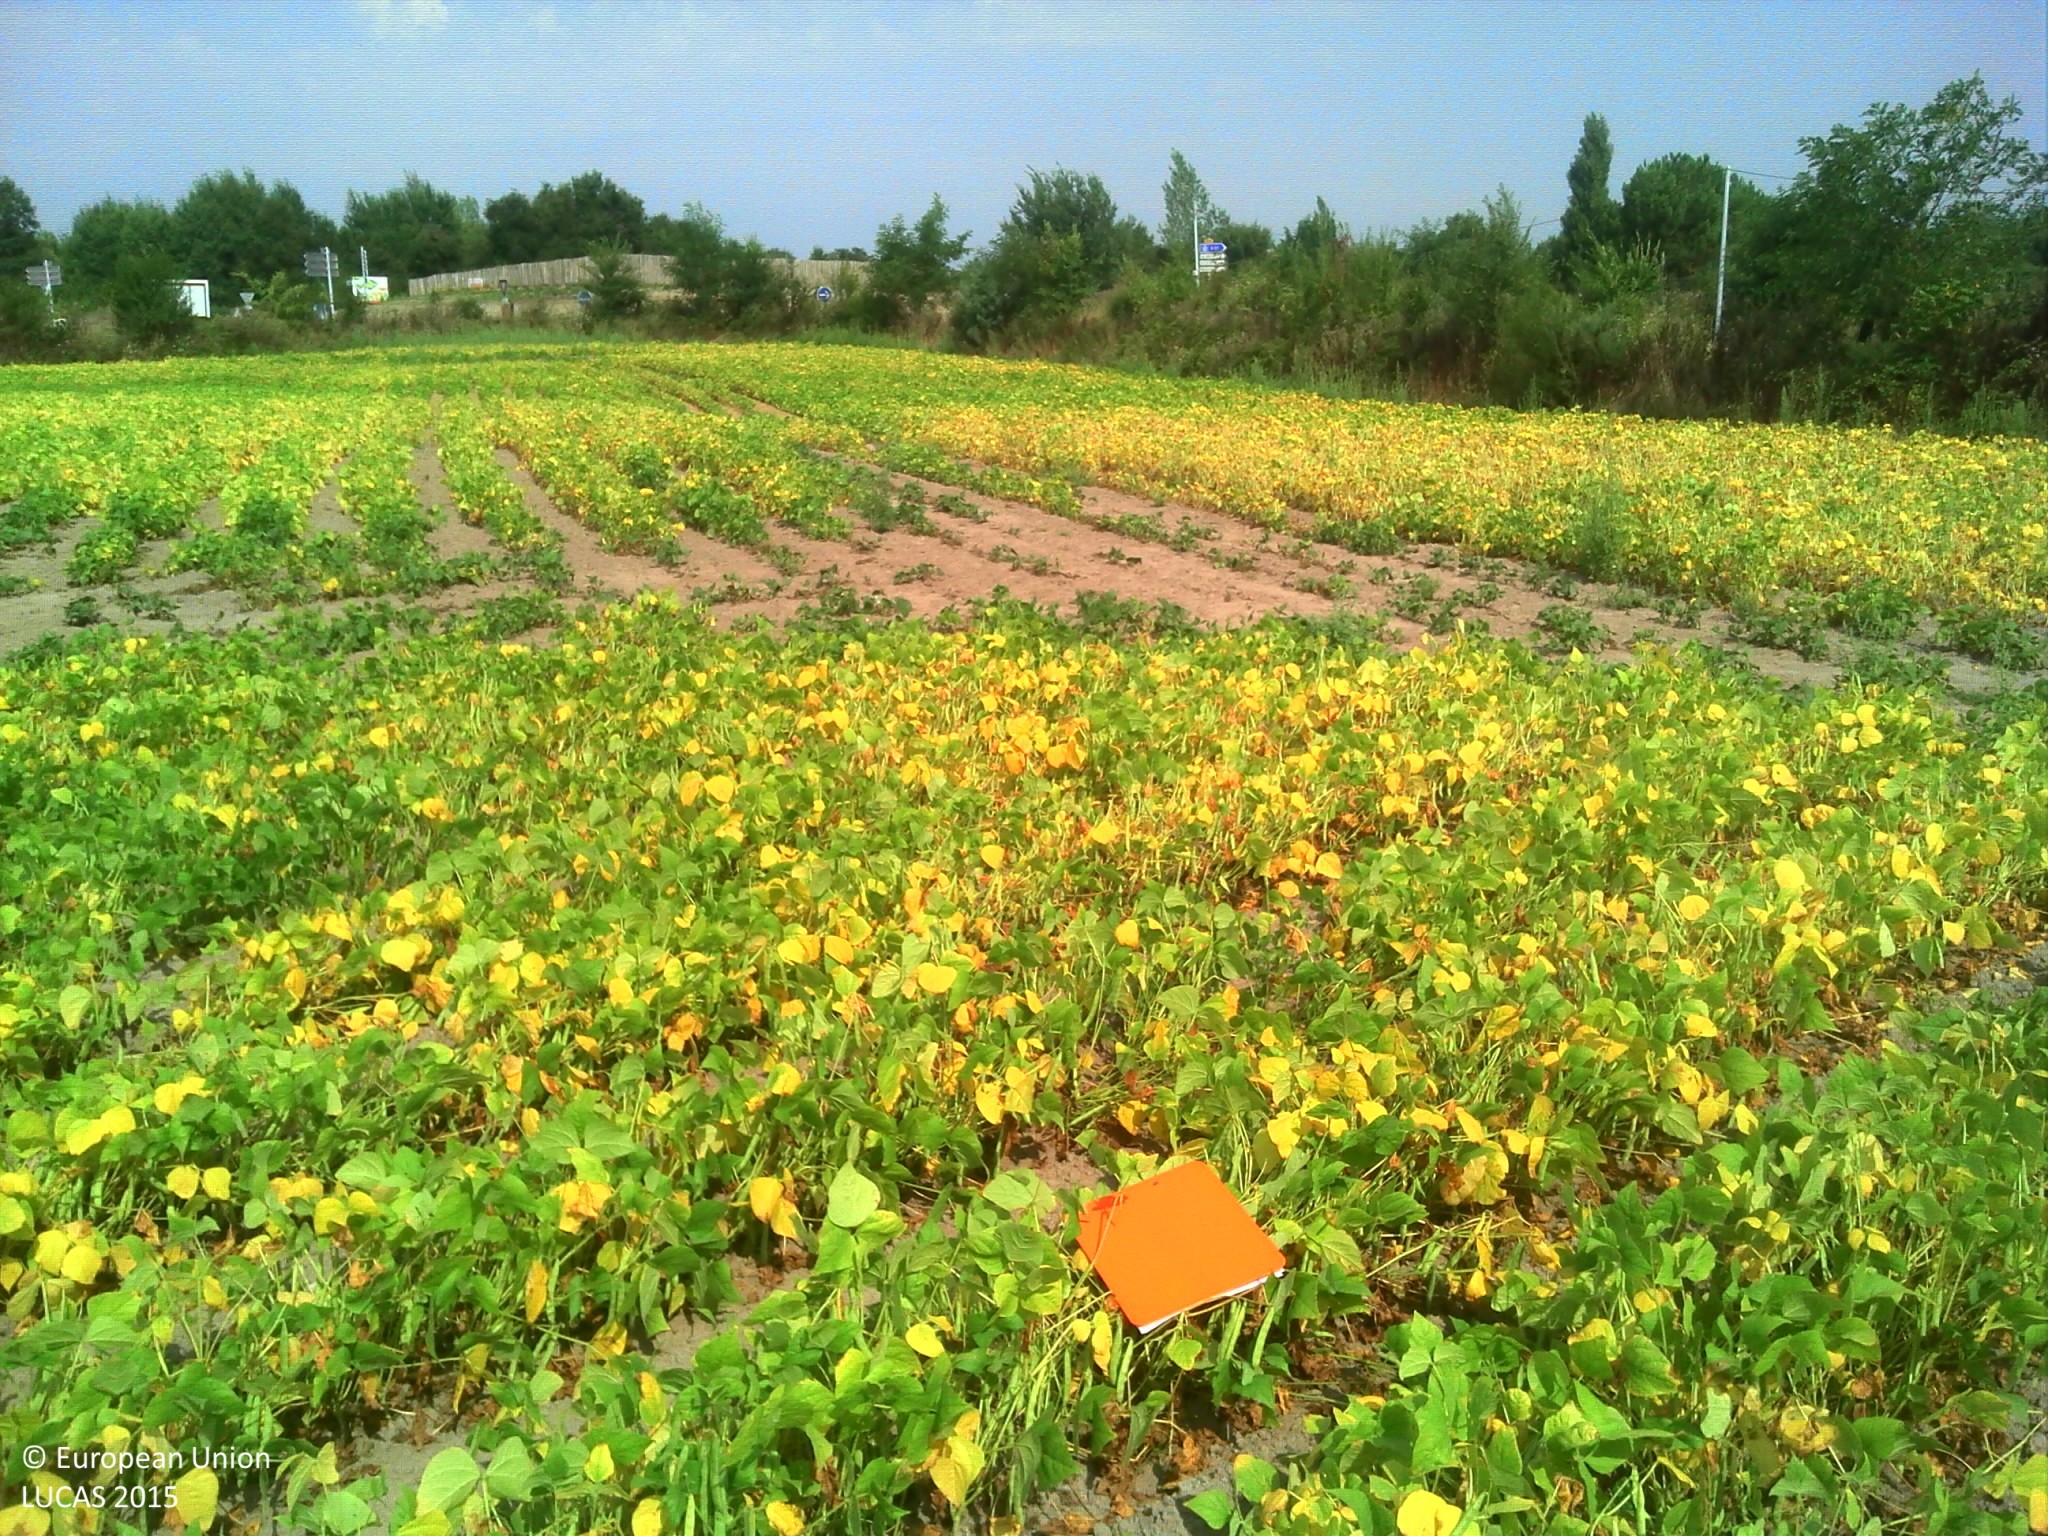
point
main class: Cropland
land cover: Dry pulses
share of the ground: > 75 %
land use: Agriculture (excluding fallow land and kitchen gardens)
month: August
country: FR
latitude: 46.7047
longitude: -1.7216
